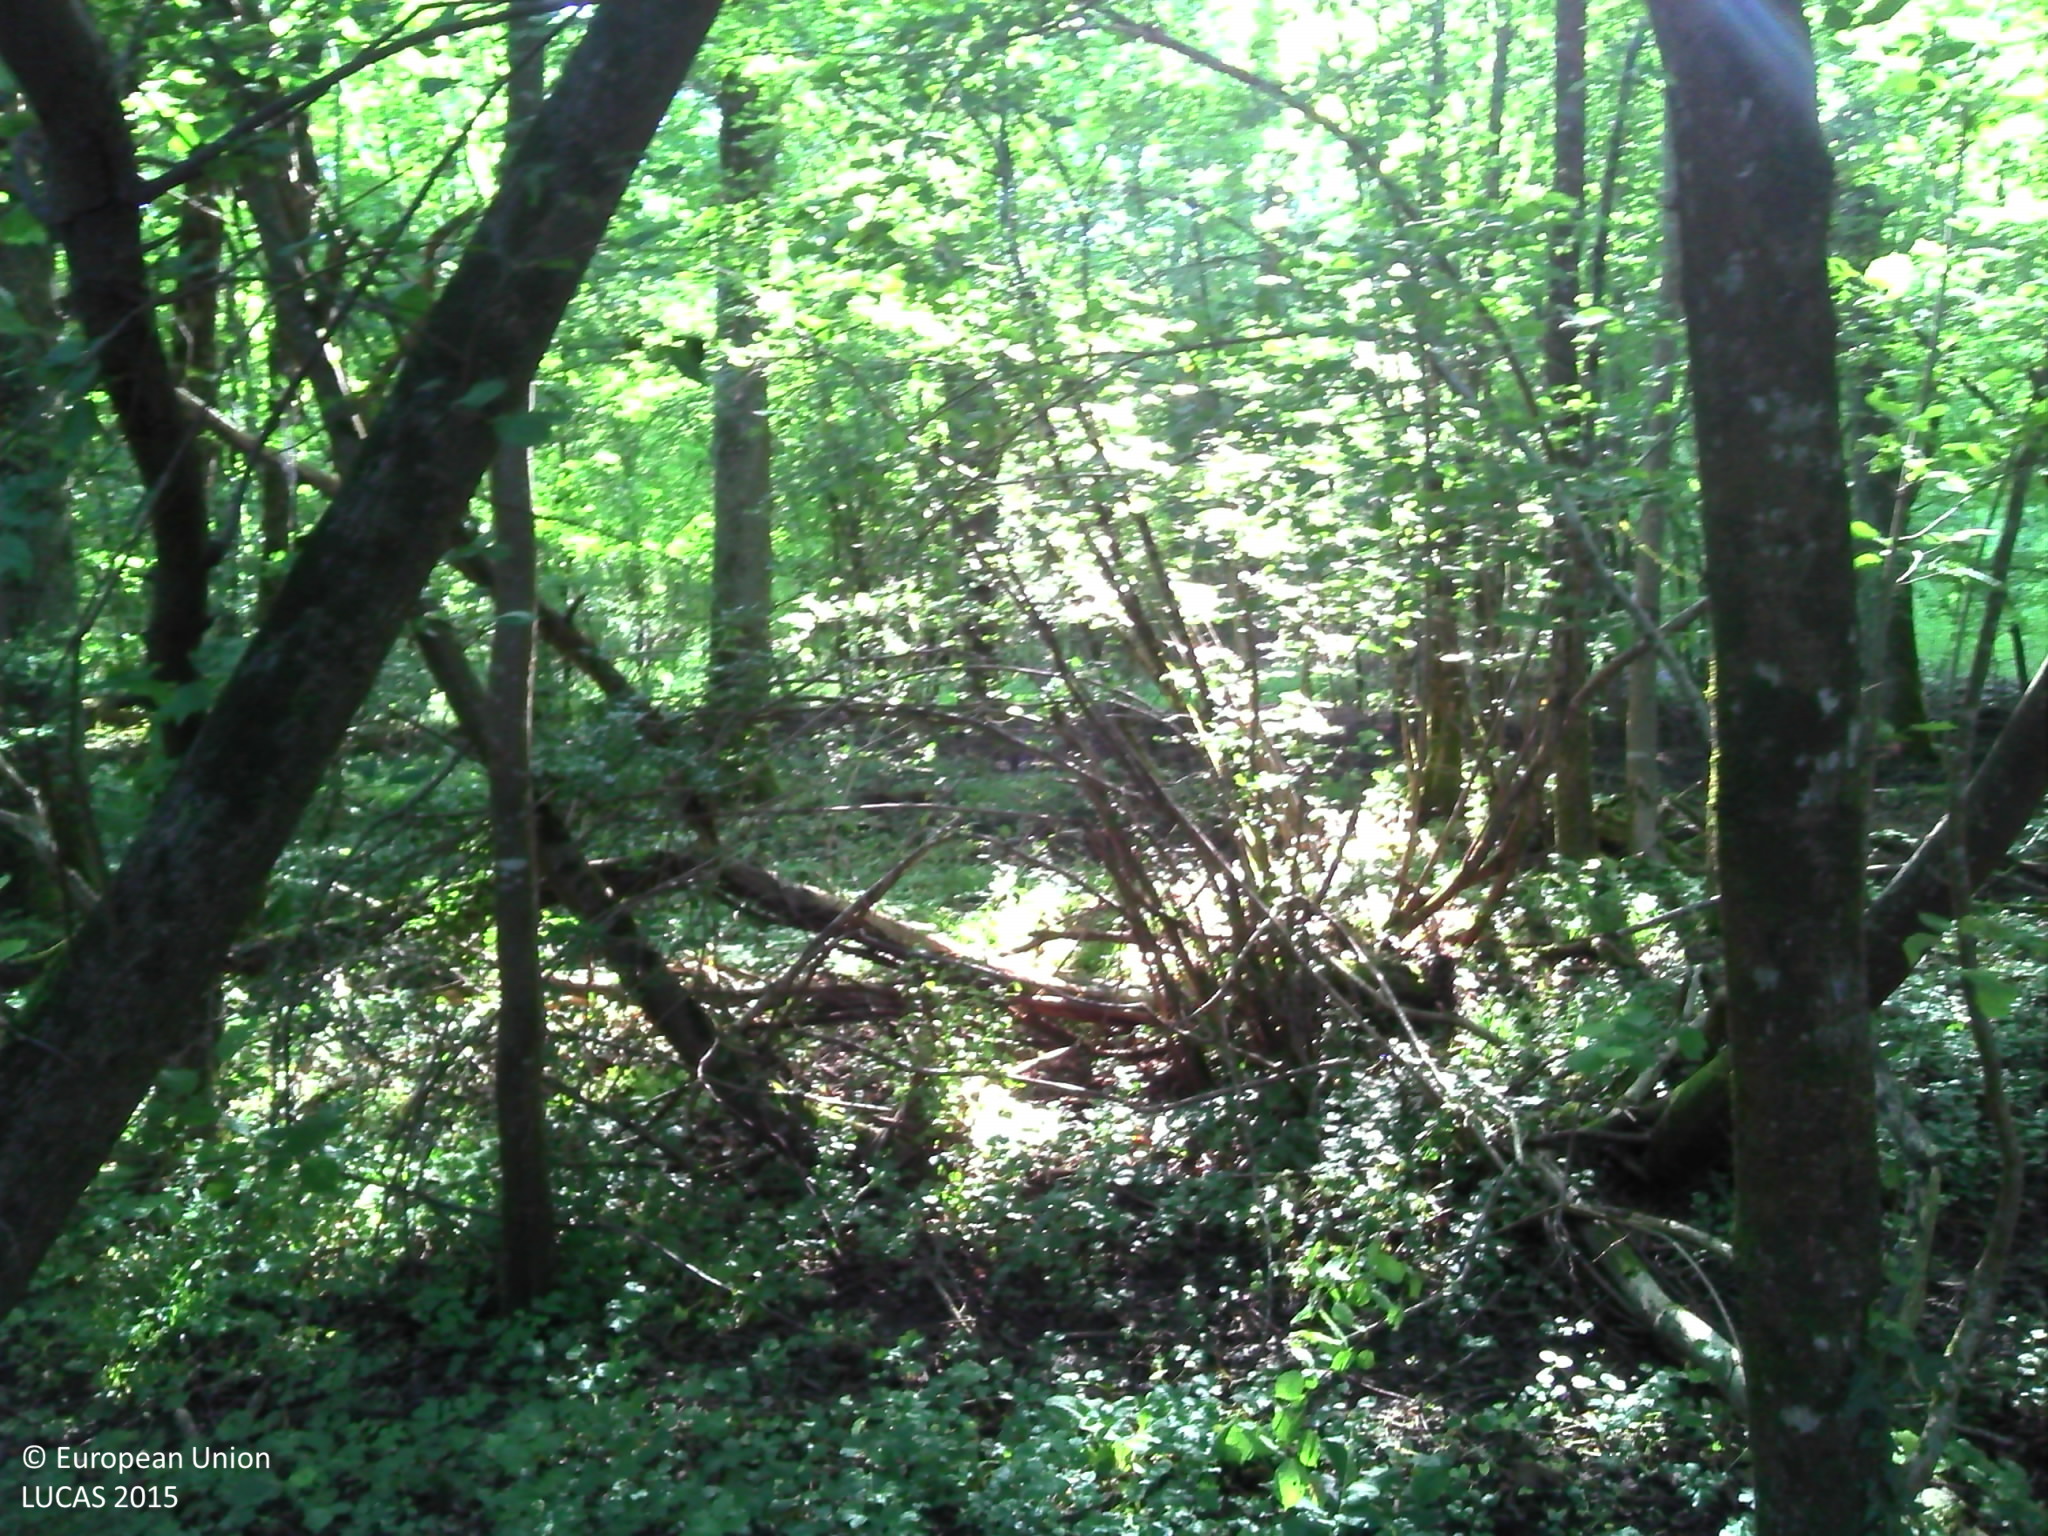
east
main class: Woodland
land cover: Broadleaved woodland
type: beech forest
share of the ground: > 75 %
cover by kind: broadleaved forest trees 90 %, herbaceous plants 10 %
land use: Forestry
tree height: > 5 m
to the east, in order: Broadleaved woodland; Ditches and canals; Fences; Broadleaved woodland
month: June
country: FR
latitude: 46.9851
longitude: 2.9352
